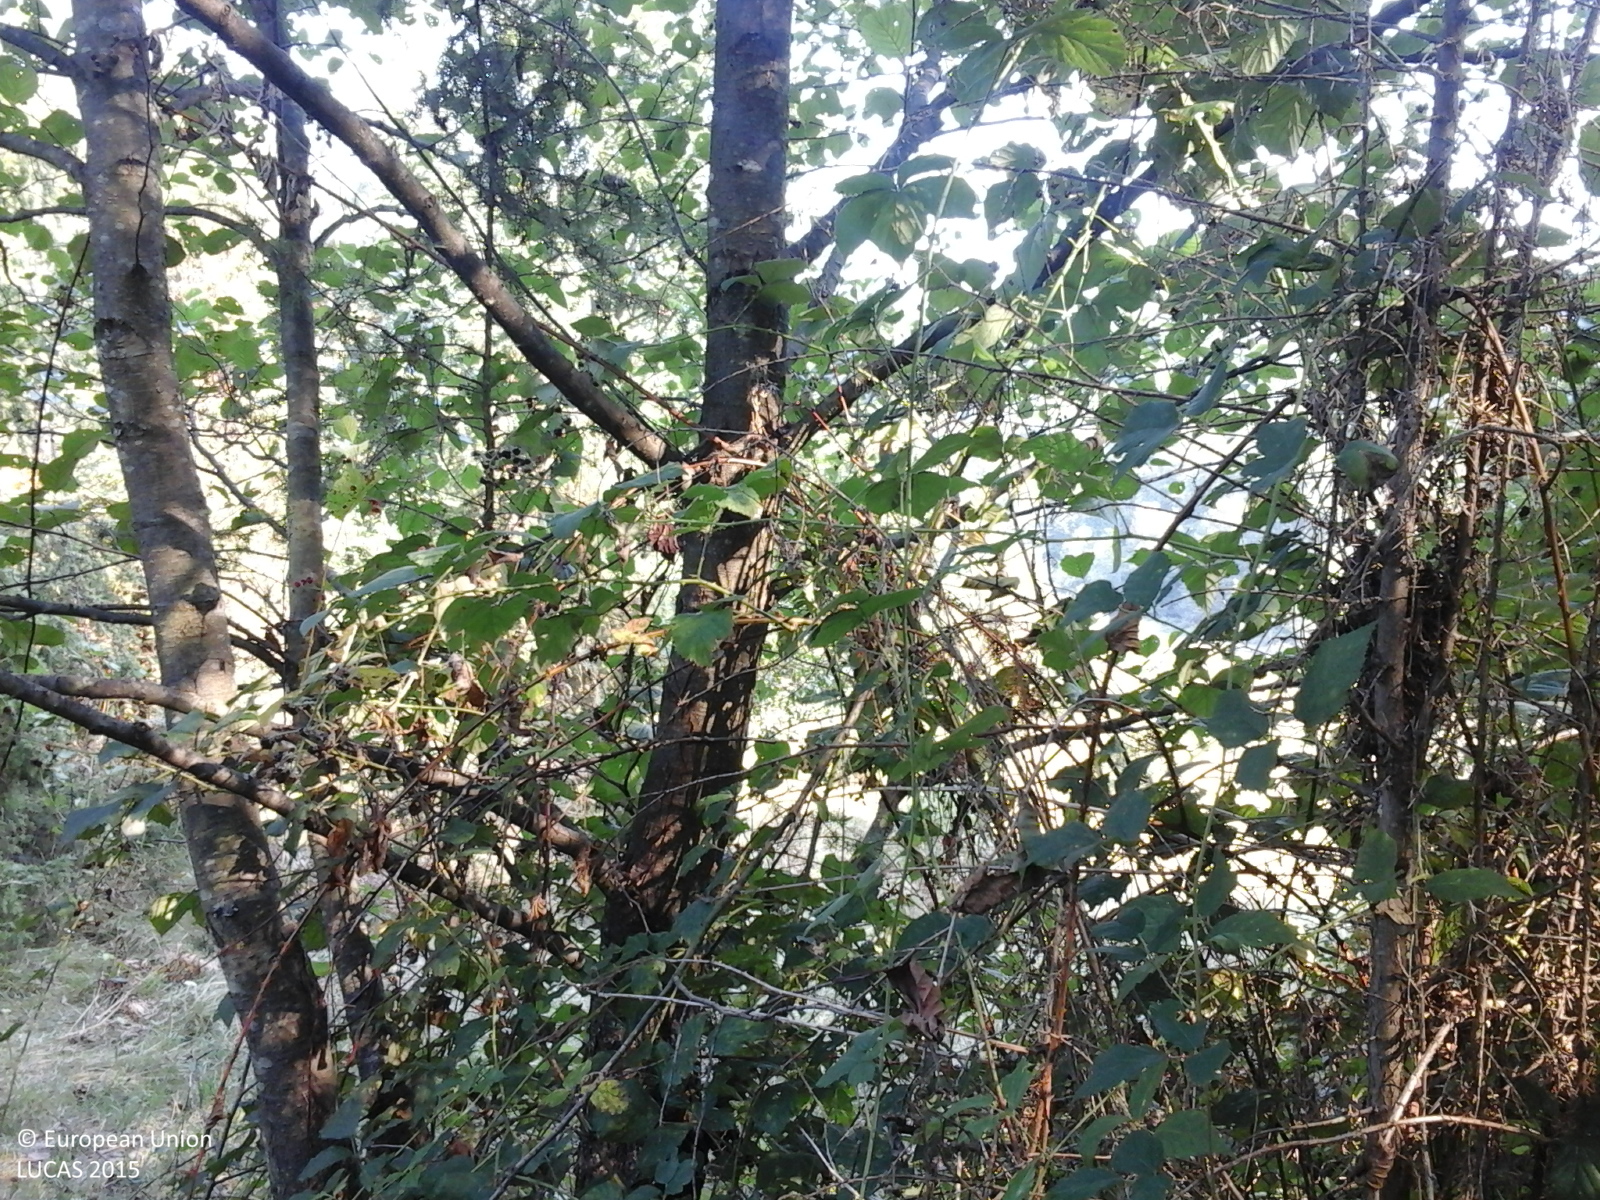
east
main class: Woodland
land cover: Other mixed woodland
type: beech forest
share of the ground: > 75 %
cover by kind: broadleaved forest trees 70 %, coniferous forest trees 30 %
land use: Forestry
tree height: > 5 m
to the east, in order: Other mixed woodland; Shrubland without tree cover; Broadleaved woodland
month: August
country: RO
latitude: 46.3066
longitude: 22.5023
